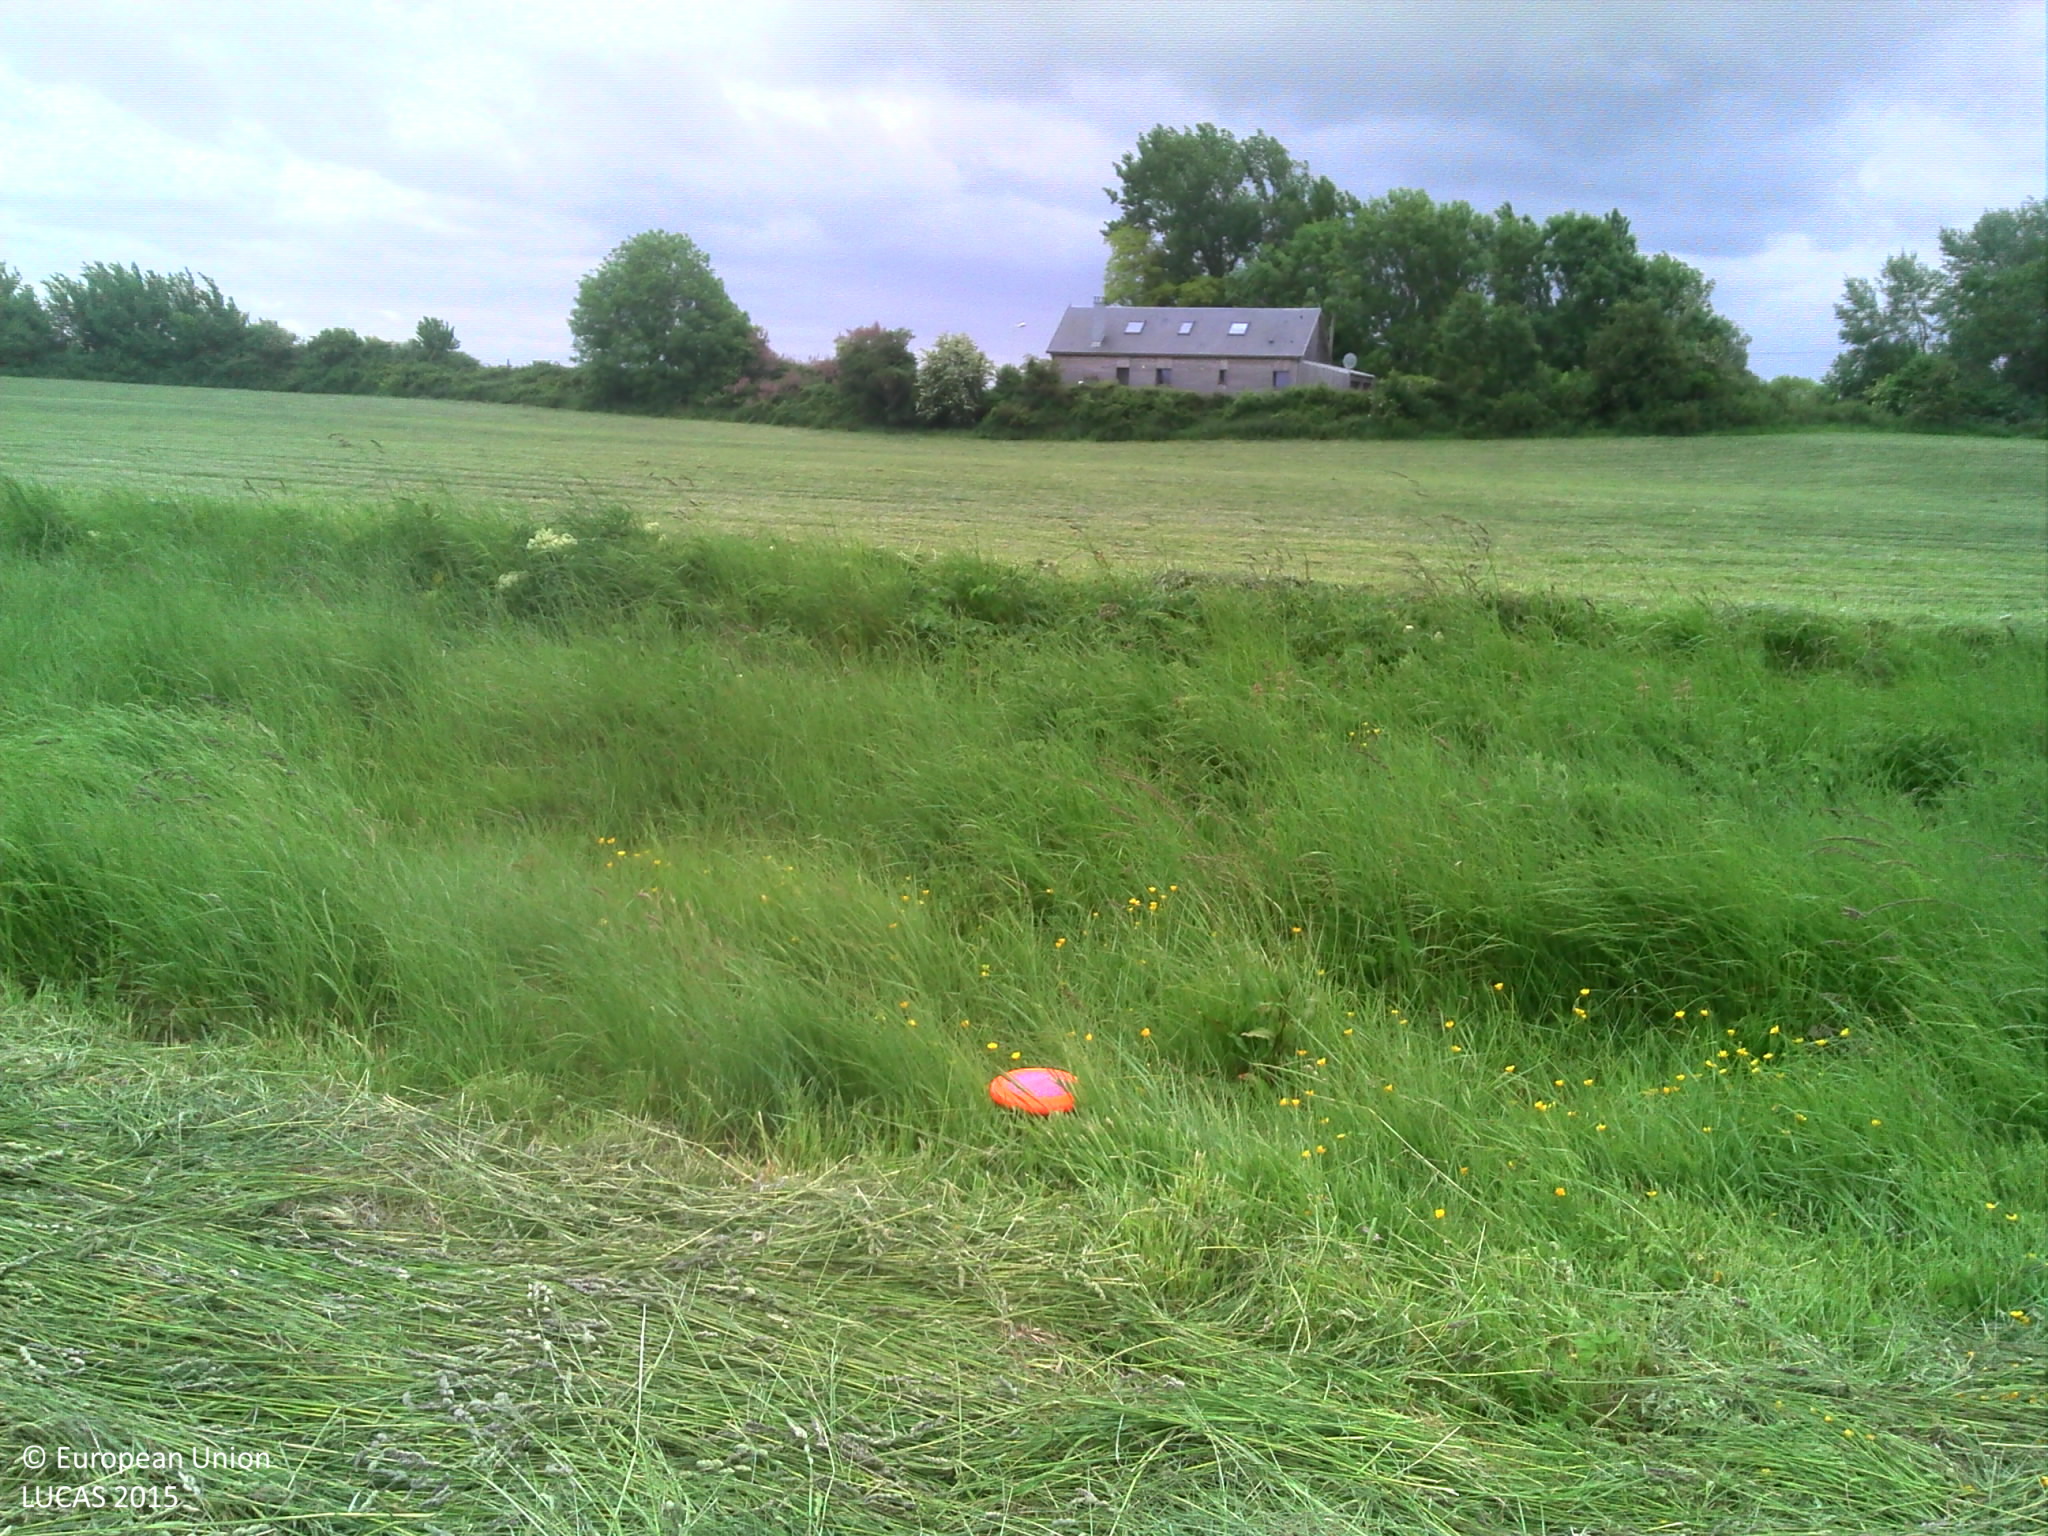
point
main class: Grassland
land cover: Grassland without tree/shrub cover
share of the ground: > 75 %
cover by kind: herbaceous plants 100 %
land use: Agriculture (excluding fallow land and kitchen gardens)
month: May
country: FR
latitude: 50.2144
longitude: 1.5591
